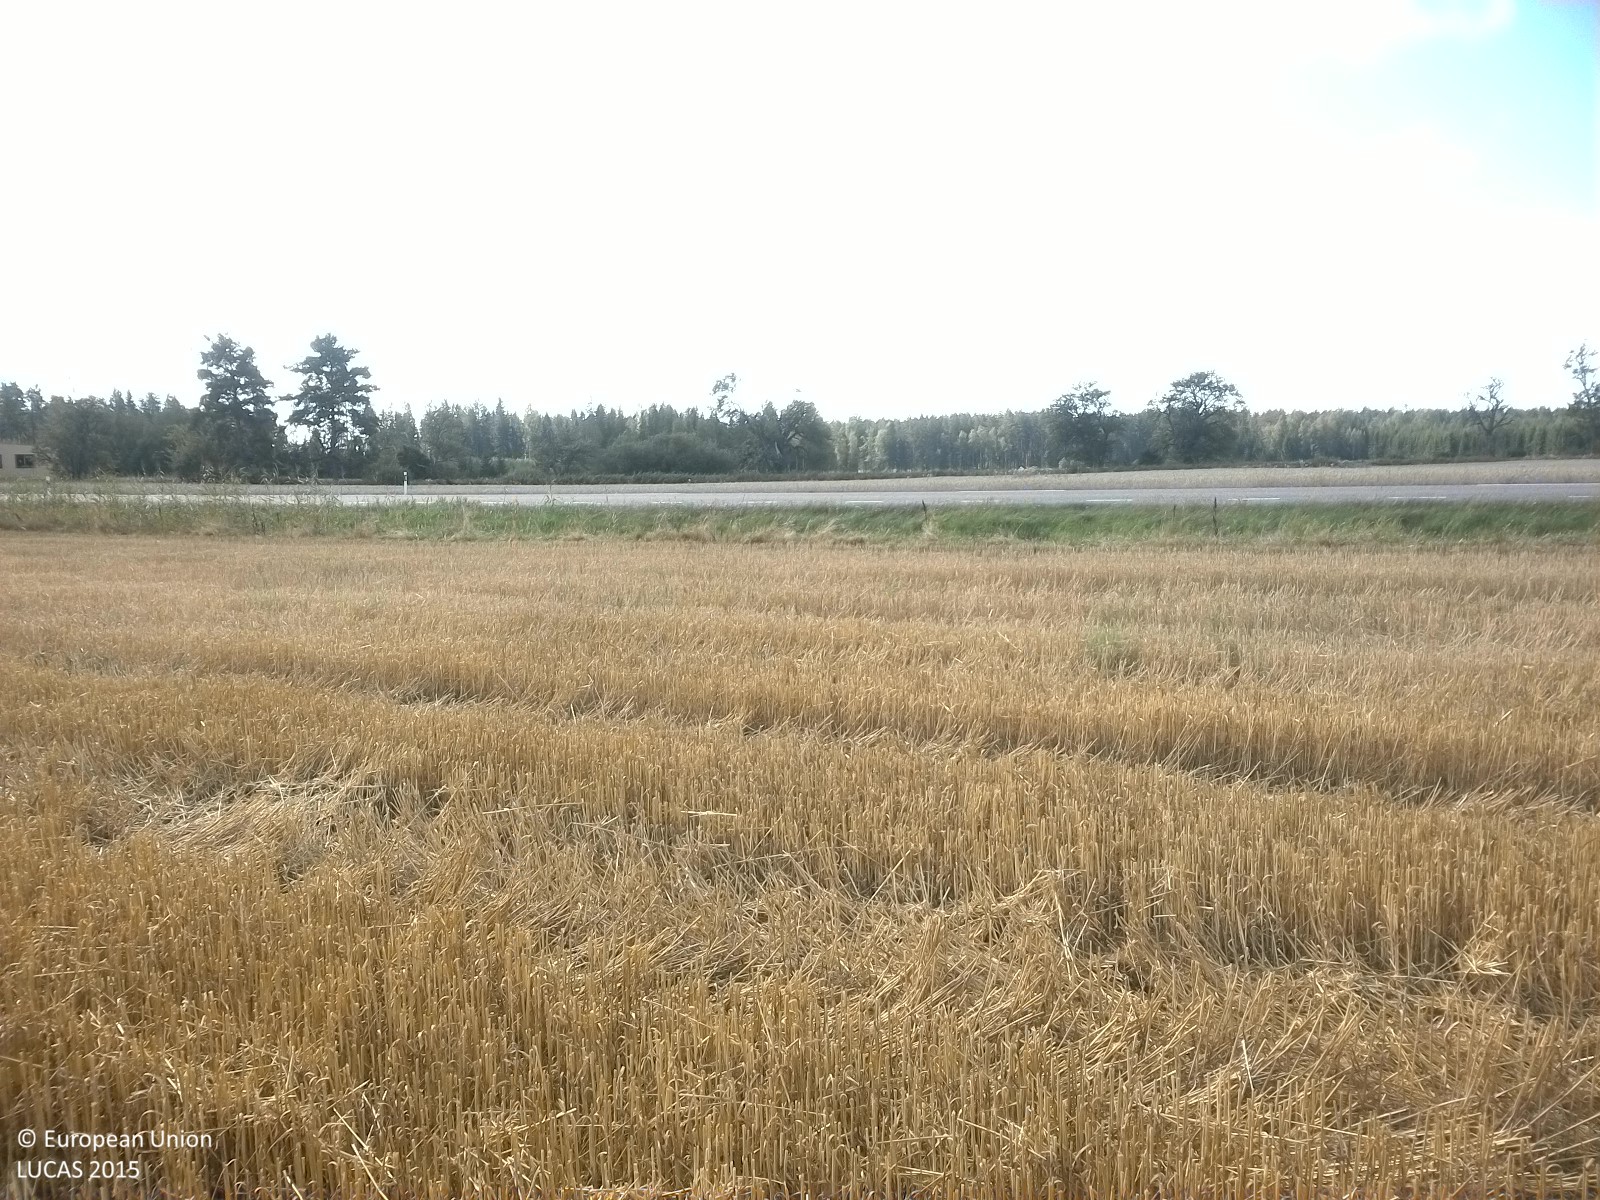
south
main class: Cropland
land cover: Common wheat
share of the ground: > 75 %
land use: Agriculture (excluding fallow land and kitchen gardens)
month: August
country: SE
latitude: 59.4370
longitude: 15.1571
